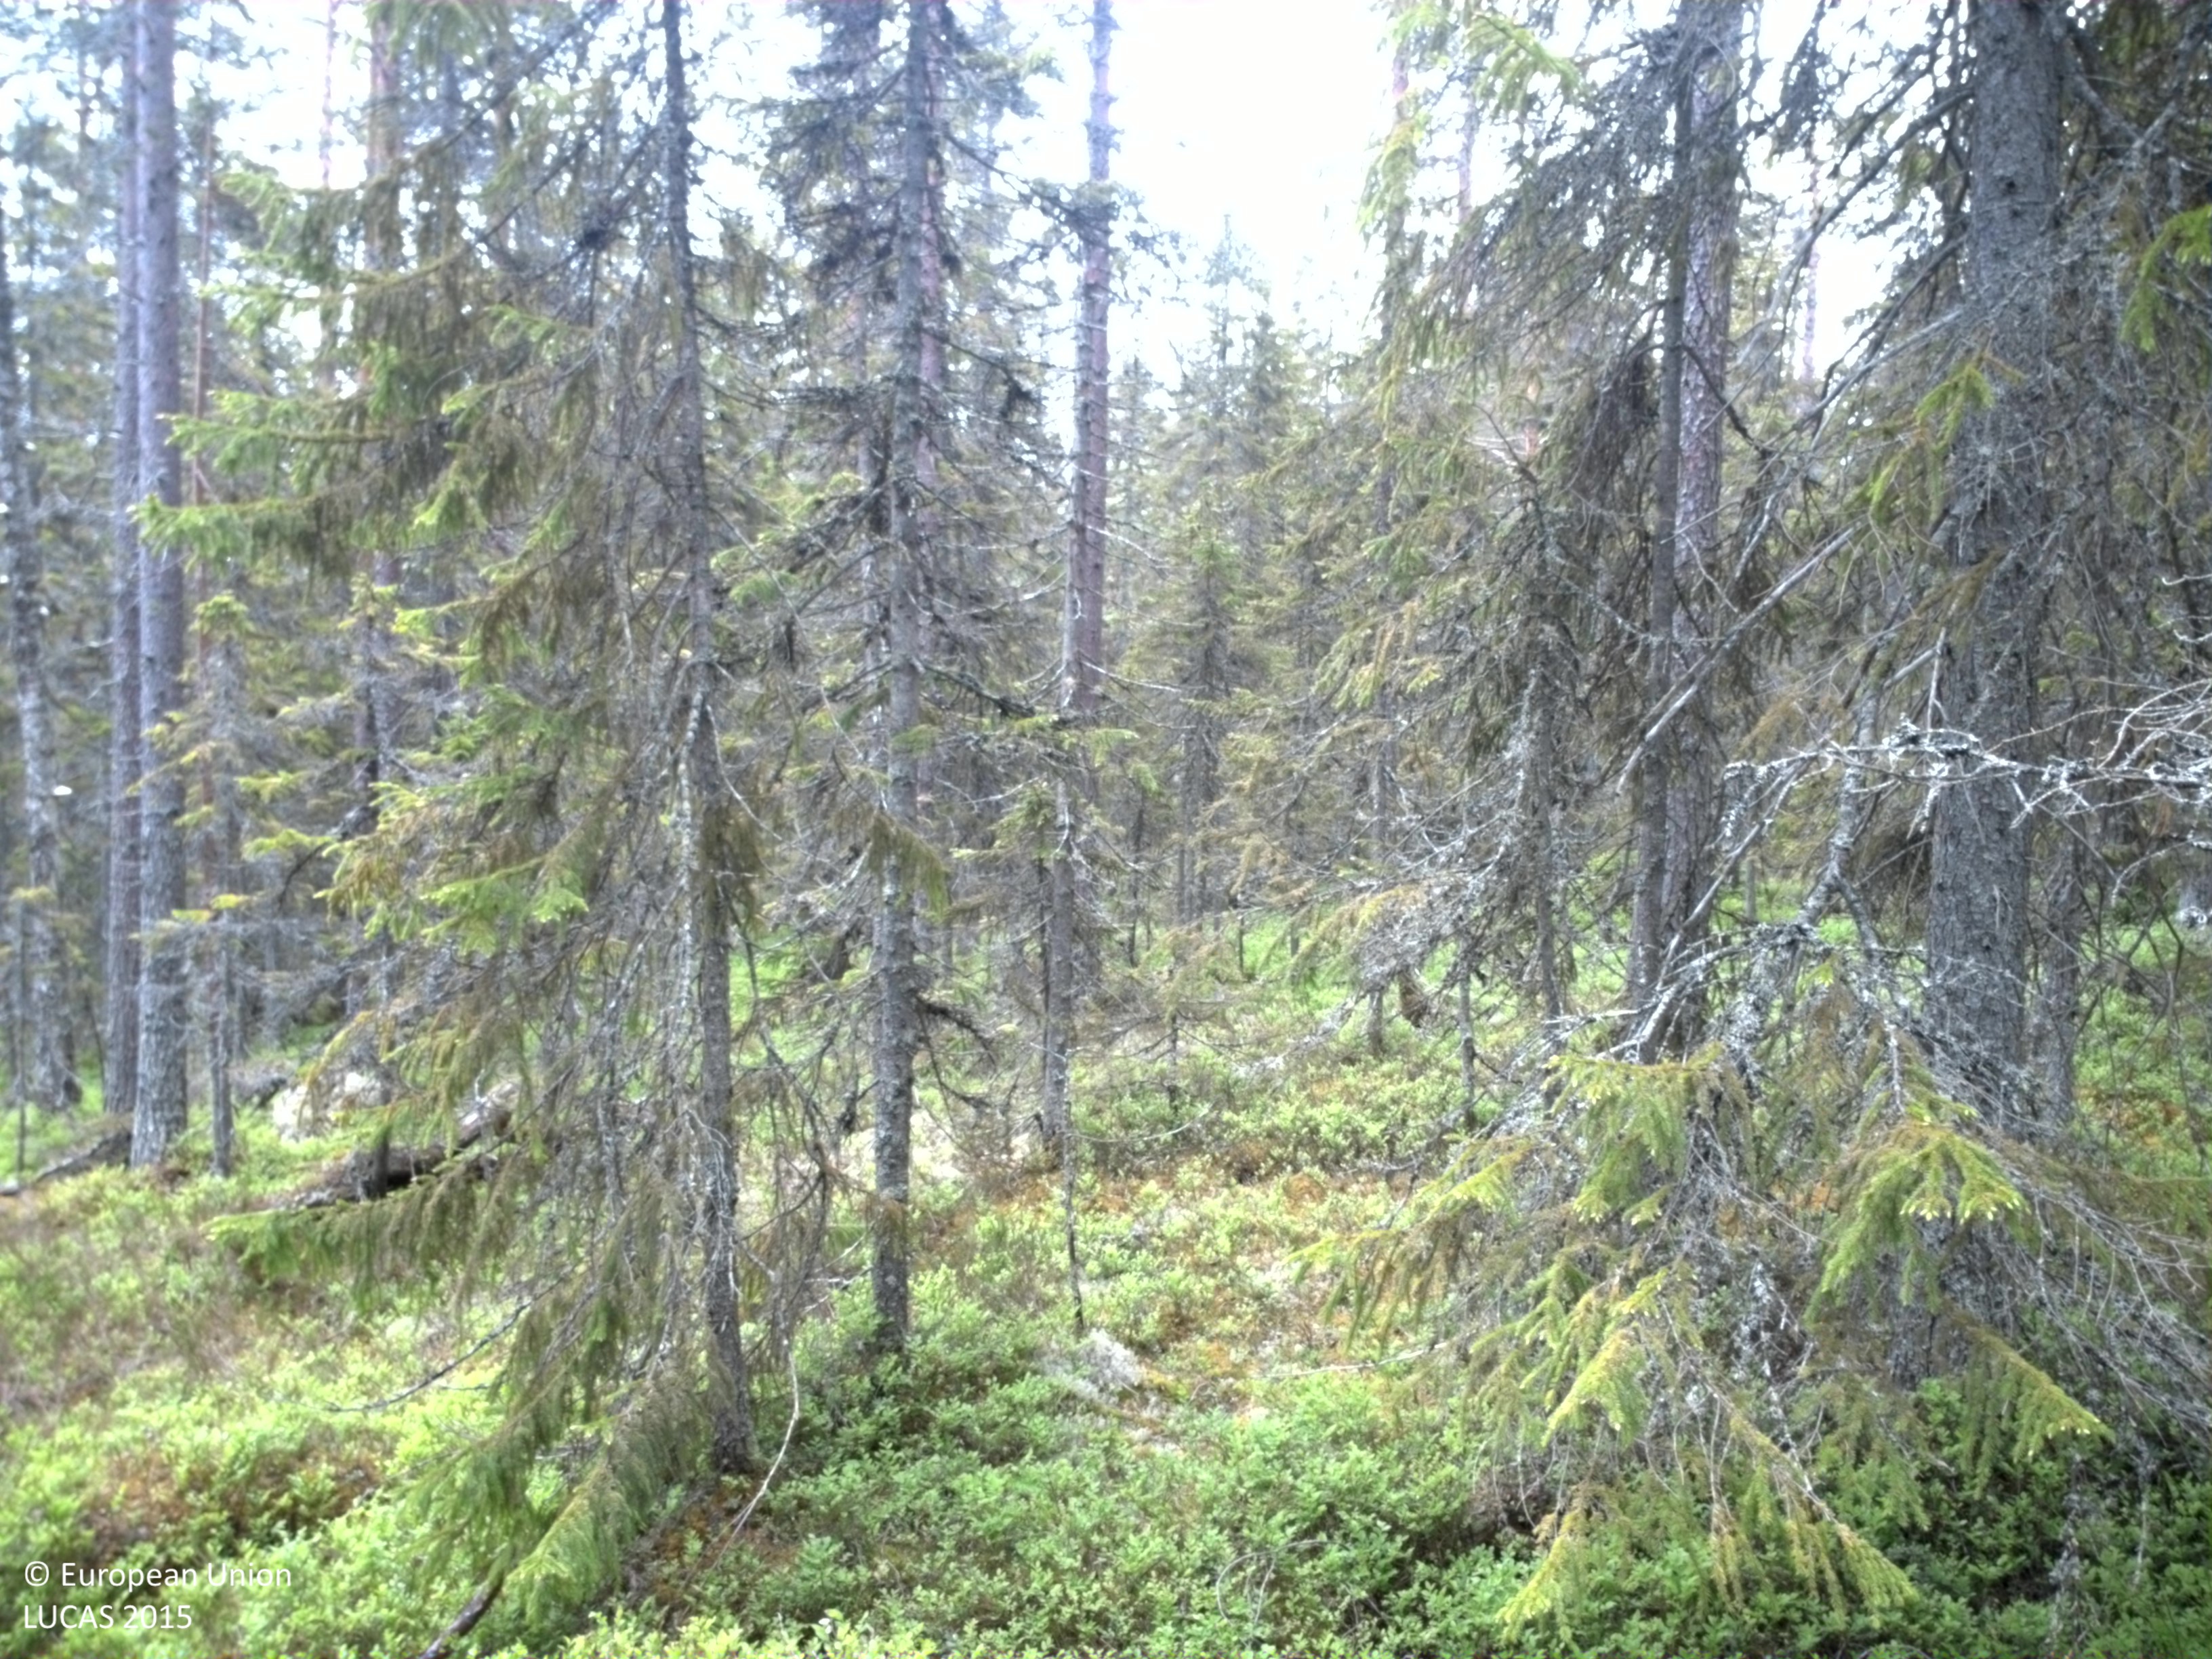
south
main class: Woodland
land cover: Other coniferous woodland
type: boreal forest
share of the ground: 50 - 75 %
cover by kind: coniferous forest trees 65 %, lichens and mosses 25 %, herbaceous plants 10 %
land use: Forestry
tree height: > 5 m
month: July
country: SE
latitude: 61.4326
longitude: 13.6052
